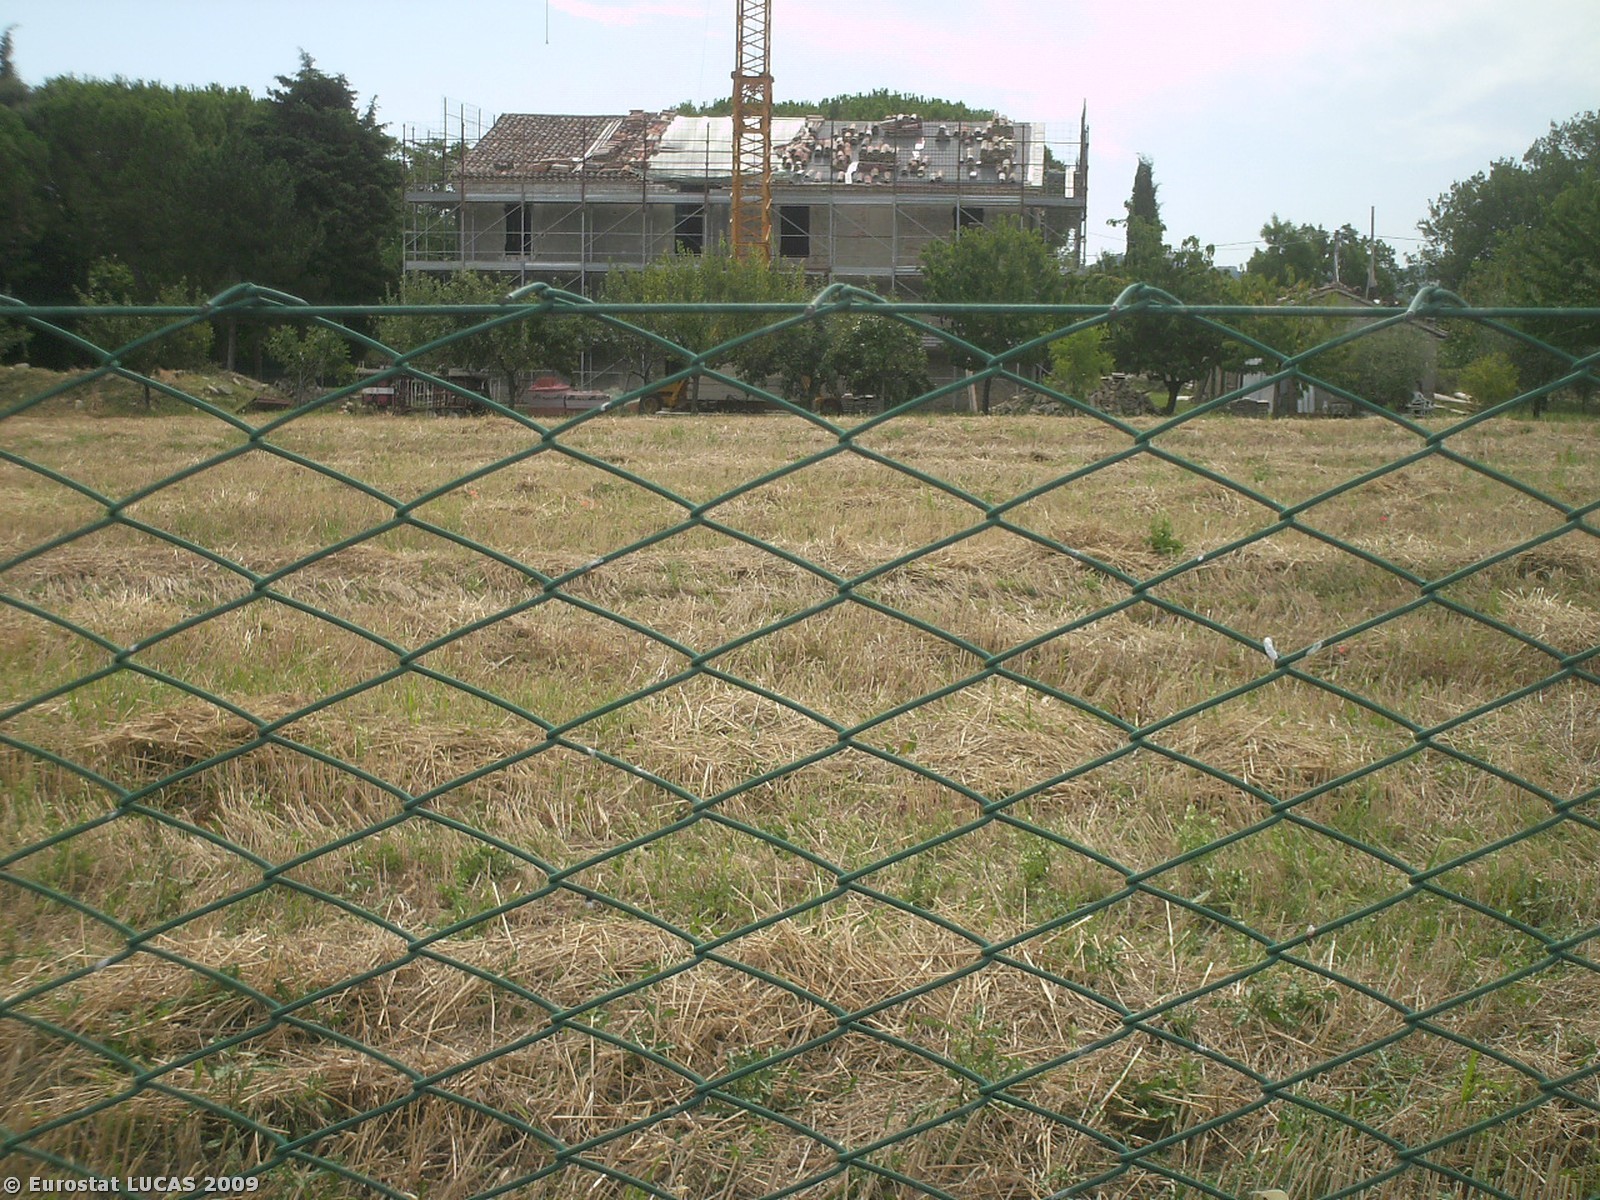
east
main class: Grassland
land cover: Grassland without tree/shrub cover
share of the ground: > 75 %
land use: Agriculture (excluding fallow land and kitchen gardens)
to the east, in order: Grassland without tree/shrub cover; Mixed woodland; Paved roads, cycling and walking lanes; Mixed woodland; Grassland without tree/shrub cover; Artificial constructions in urban areas
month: July
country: IT
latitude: 43.7502
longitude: 12.9115
